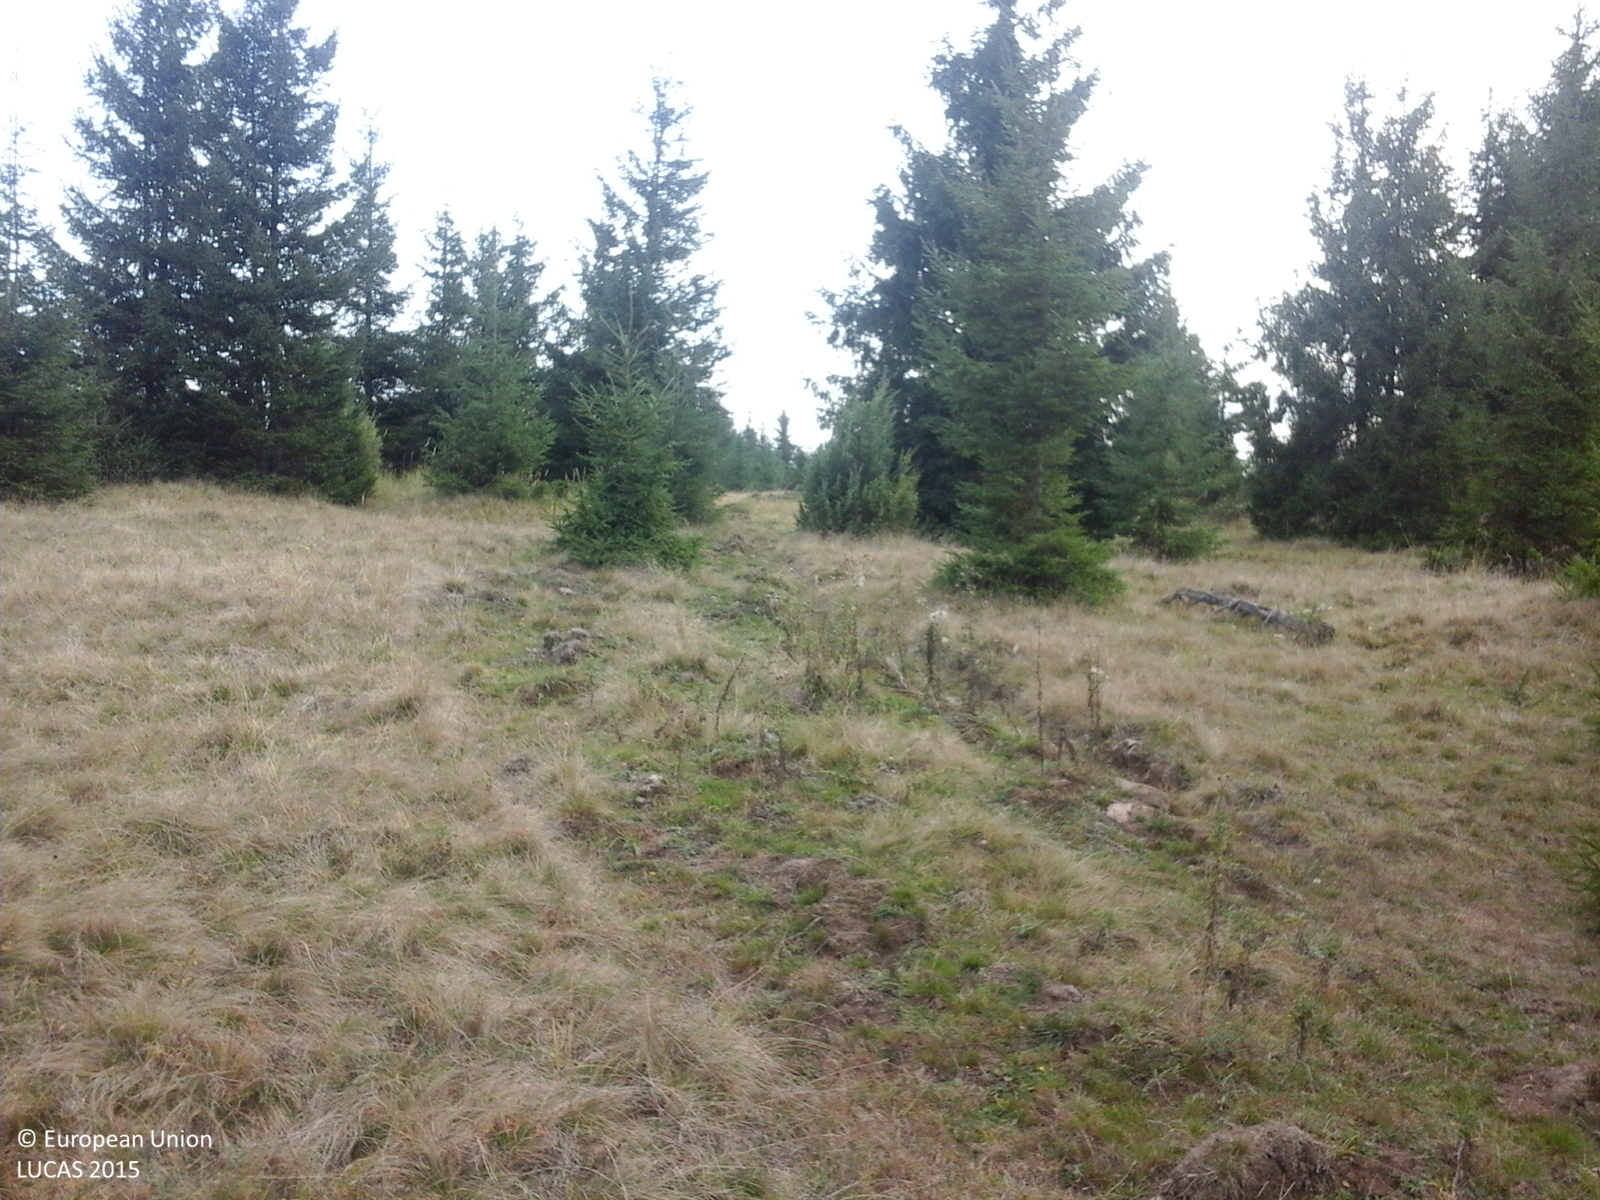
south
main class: Grassland
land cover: Grassland with sparse tree/shrub cover
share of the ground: > 75 %
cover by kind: herbaceous plants 85 %, shrubs 10 %, broadleaved forest trees 5 %
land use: Fallow land
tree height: < 5 m
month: October
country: RO
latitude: 46.3907
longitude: 25.4652
